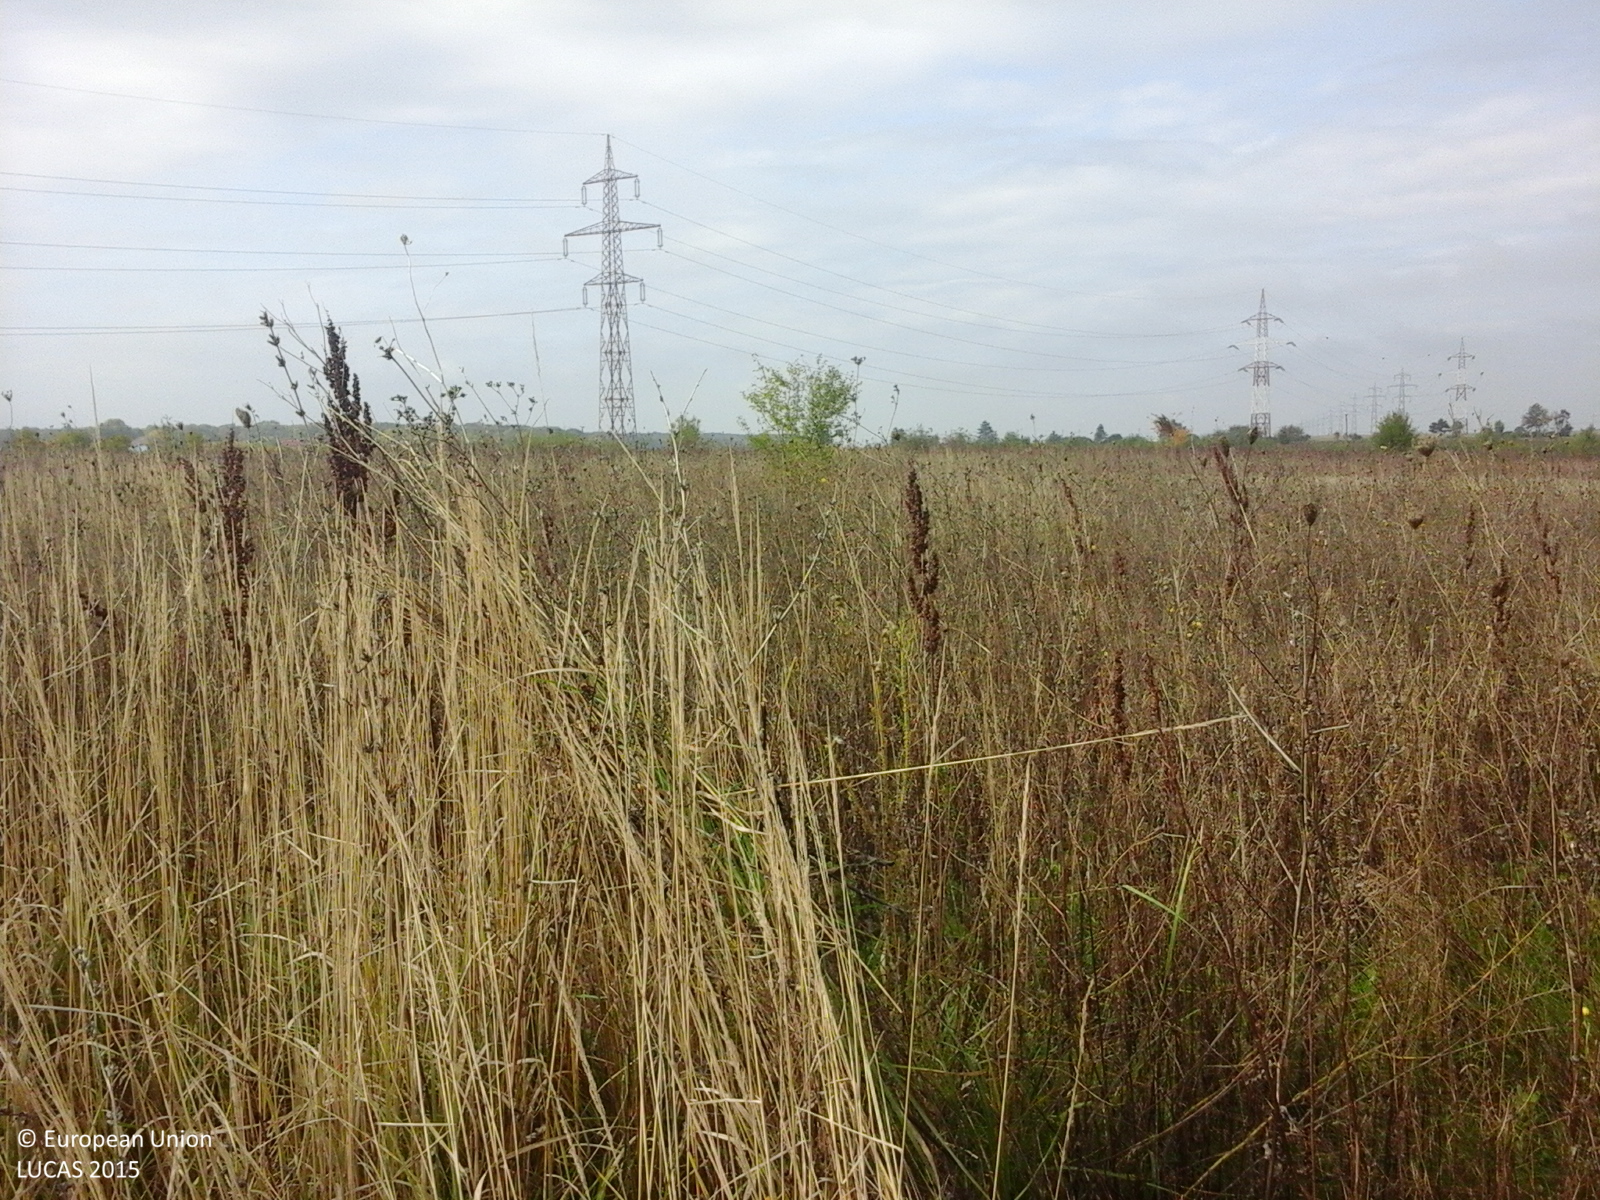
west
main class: Grassland
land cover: Spontaneously vegetated surfaces
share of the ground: > 75 %
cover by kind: herbaceous plants 100 %
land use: Fallow land
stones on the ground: < 10 %
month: October
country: RO
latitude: 44.6469
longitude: 26.0820
